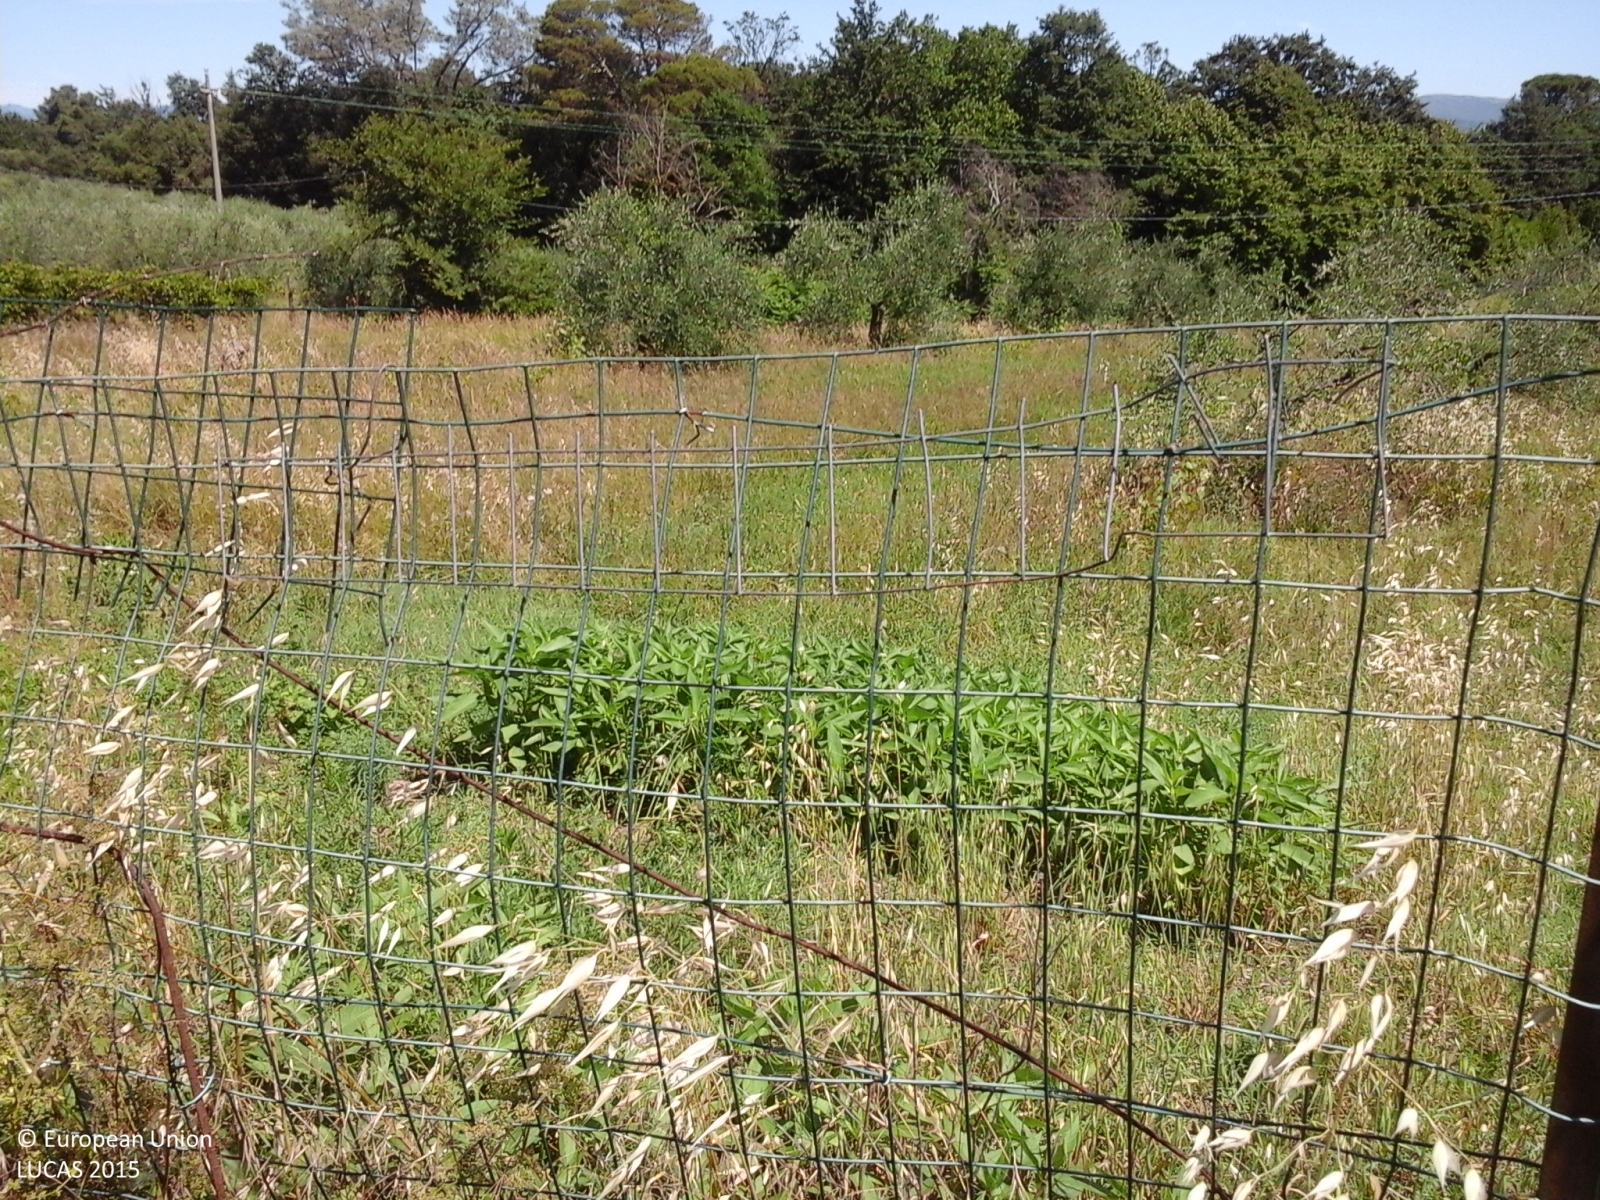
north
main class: Grassland
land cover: Grassland without tree/shrub cover
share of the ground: > 75 %
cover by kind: herbaceous plants 100 %
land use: Agriculture (excluding fallow land and kitchen gardens)
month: June
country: IT
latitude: 43.7857
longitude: 11.0783
